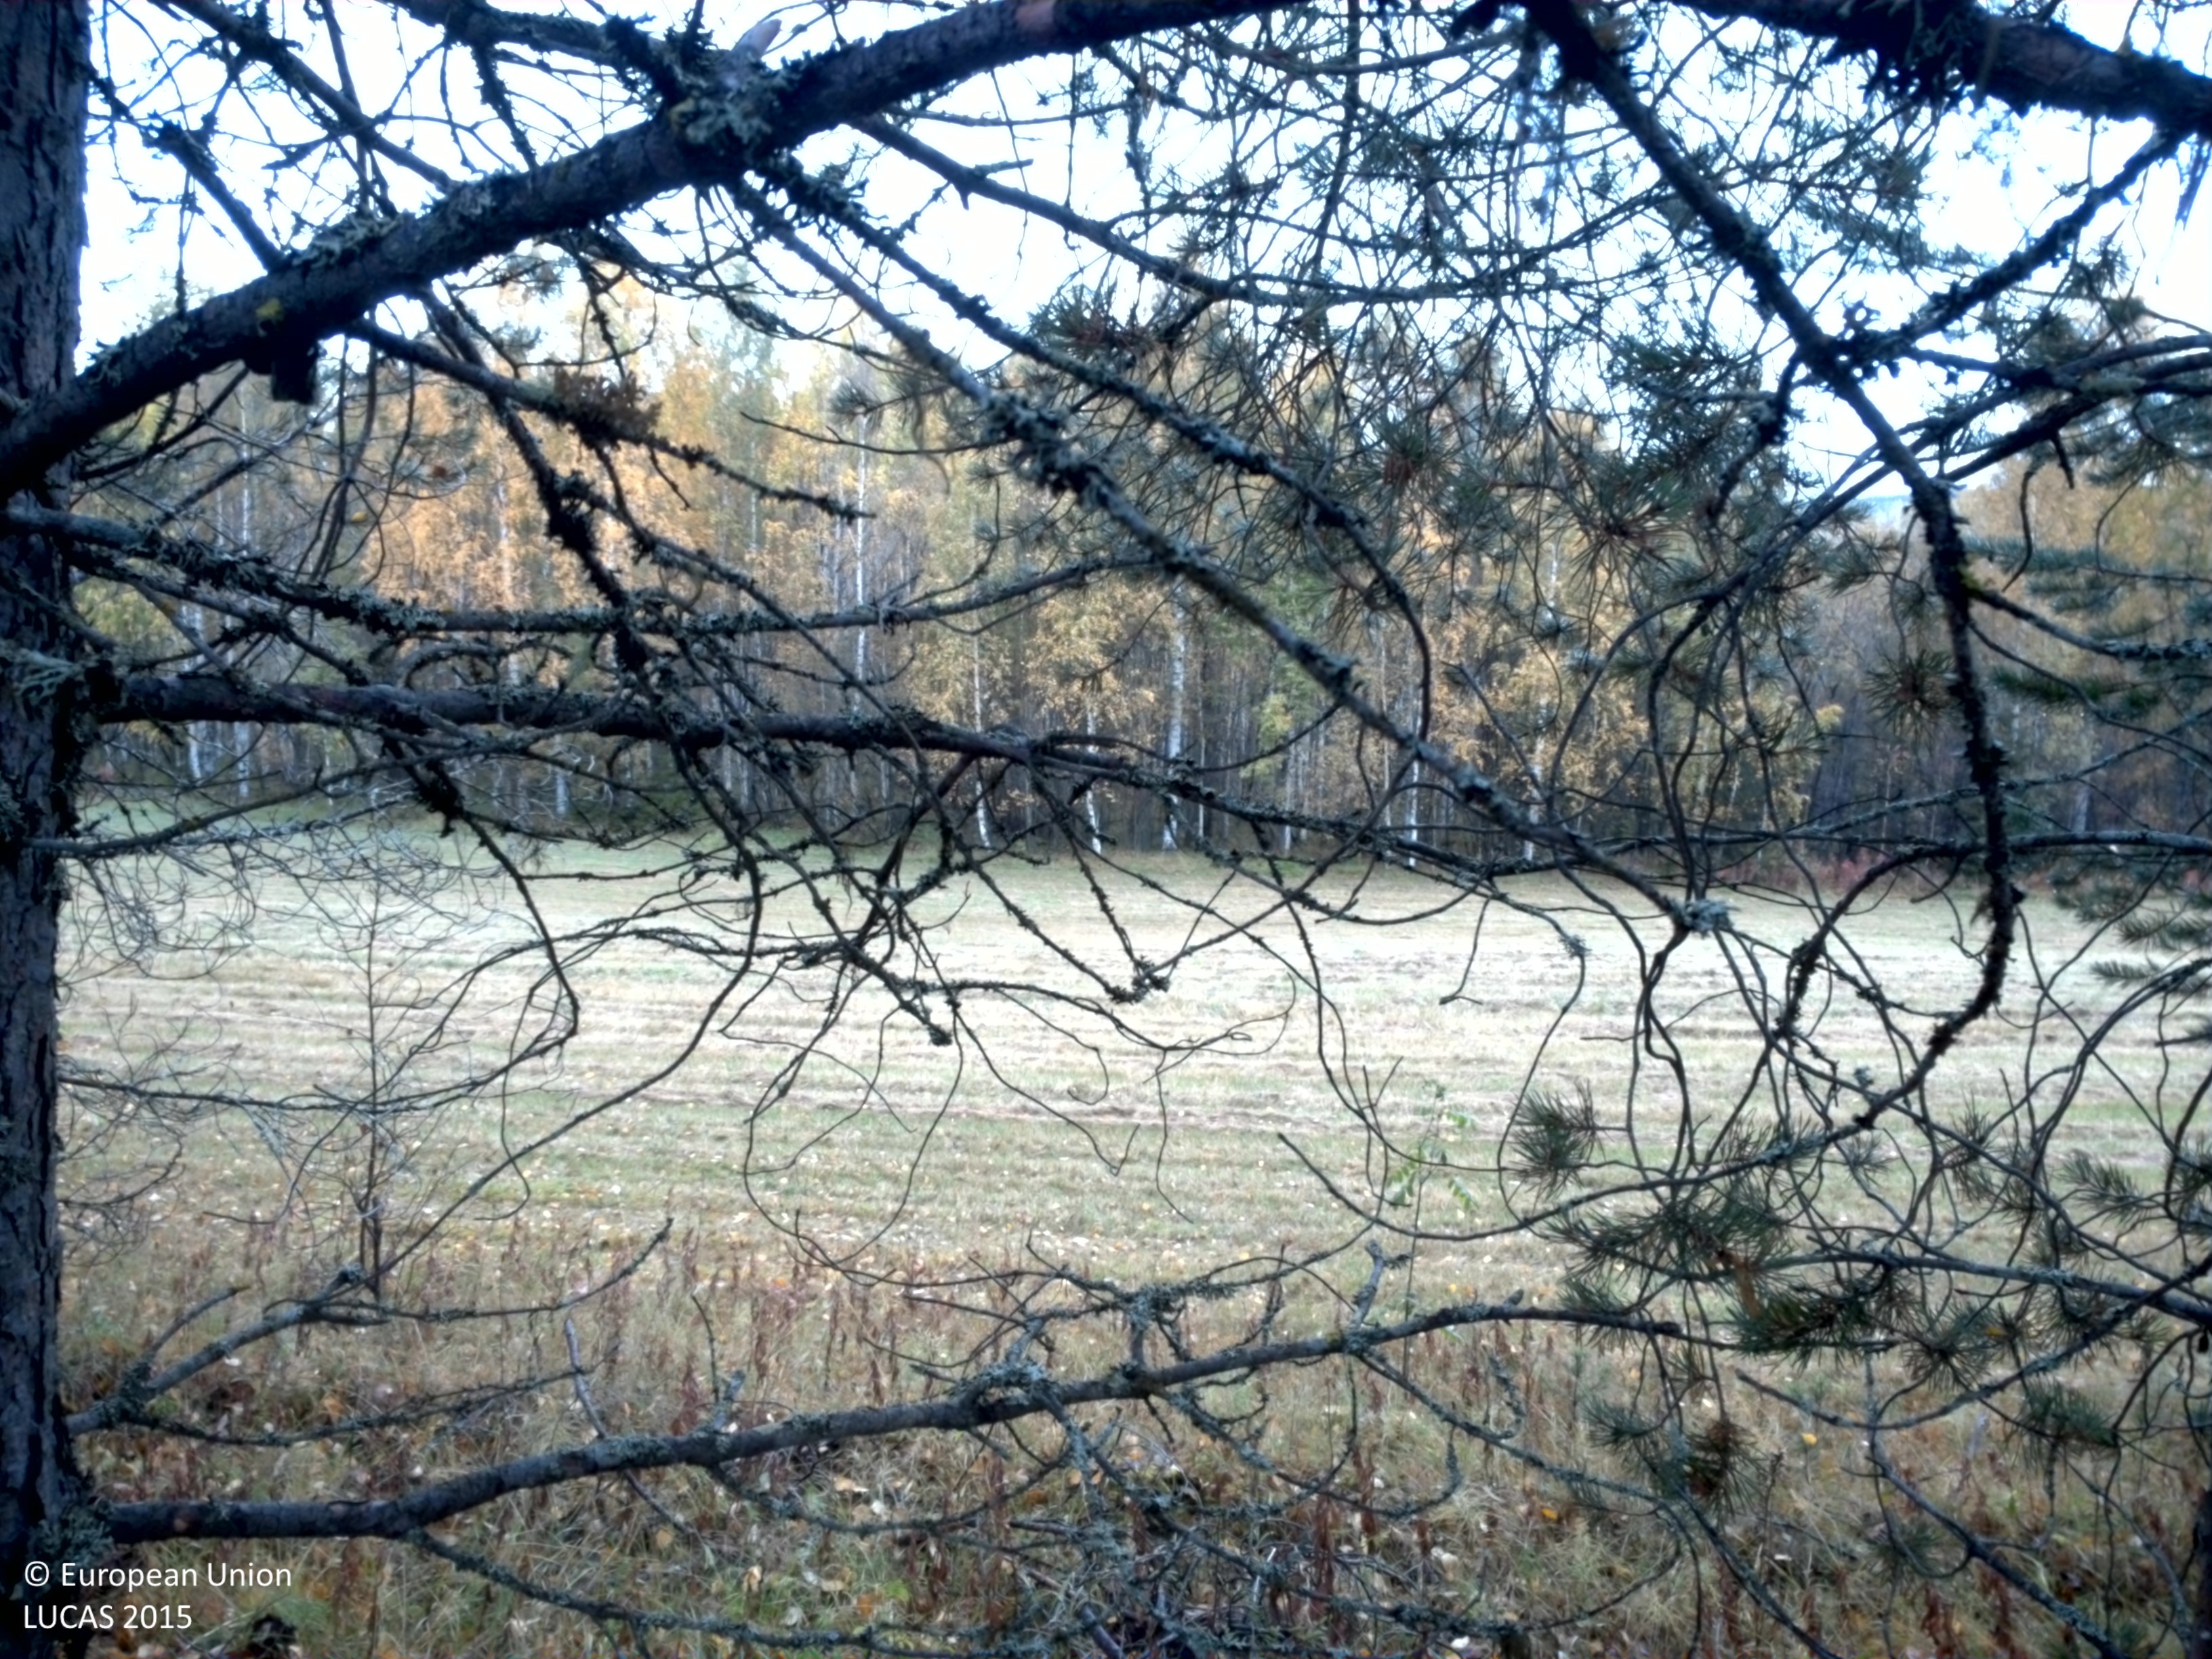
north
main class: Woodland
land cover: Pine dominated mixed woodland
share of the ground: 25 - 50 %
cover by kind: herbaceous plants 35 %, coniferous forest trees 25 %, shrubs 25 %, broadleaved forest trees 15 %
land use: Forestry
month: September
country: SE
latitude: 65.8479
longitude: 21.4692
